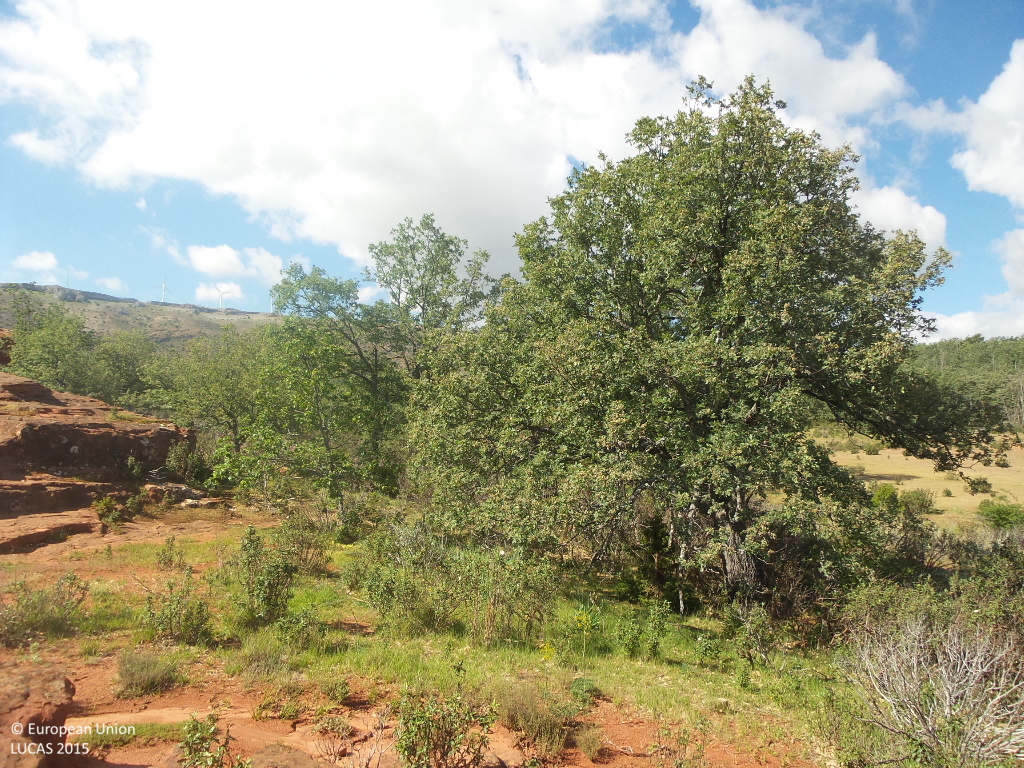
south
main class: Shrubland
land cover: Shrubland with sparse tree cover
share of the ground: 50 - 75 %
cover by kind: shrubs 50 %, consolidated bare surface 30 %, lichens and mosses 10 %, broadleaved forest trees 5 %, unconsolidated bare surface 5 %
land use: Semi-natural and natural areas not in use
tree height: > 5 m
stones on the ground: 25 - 50 %
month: June
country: ES
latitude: 41.2947
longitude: -3.0444
